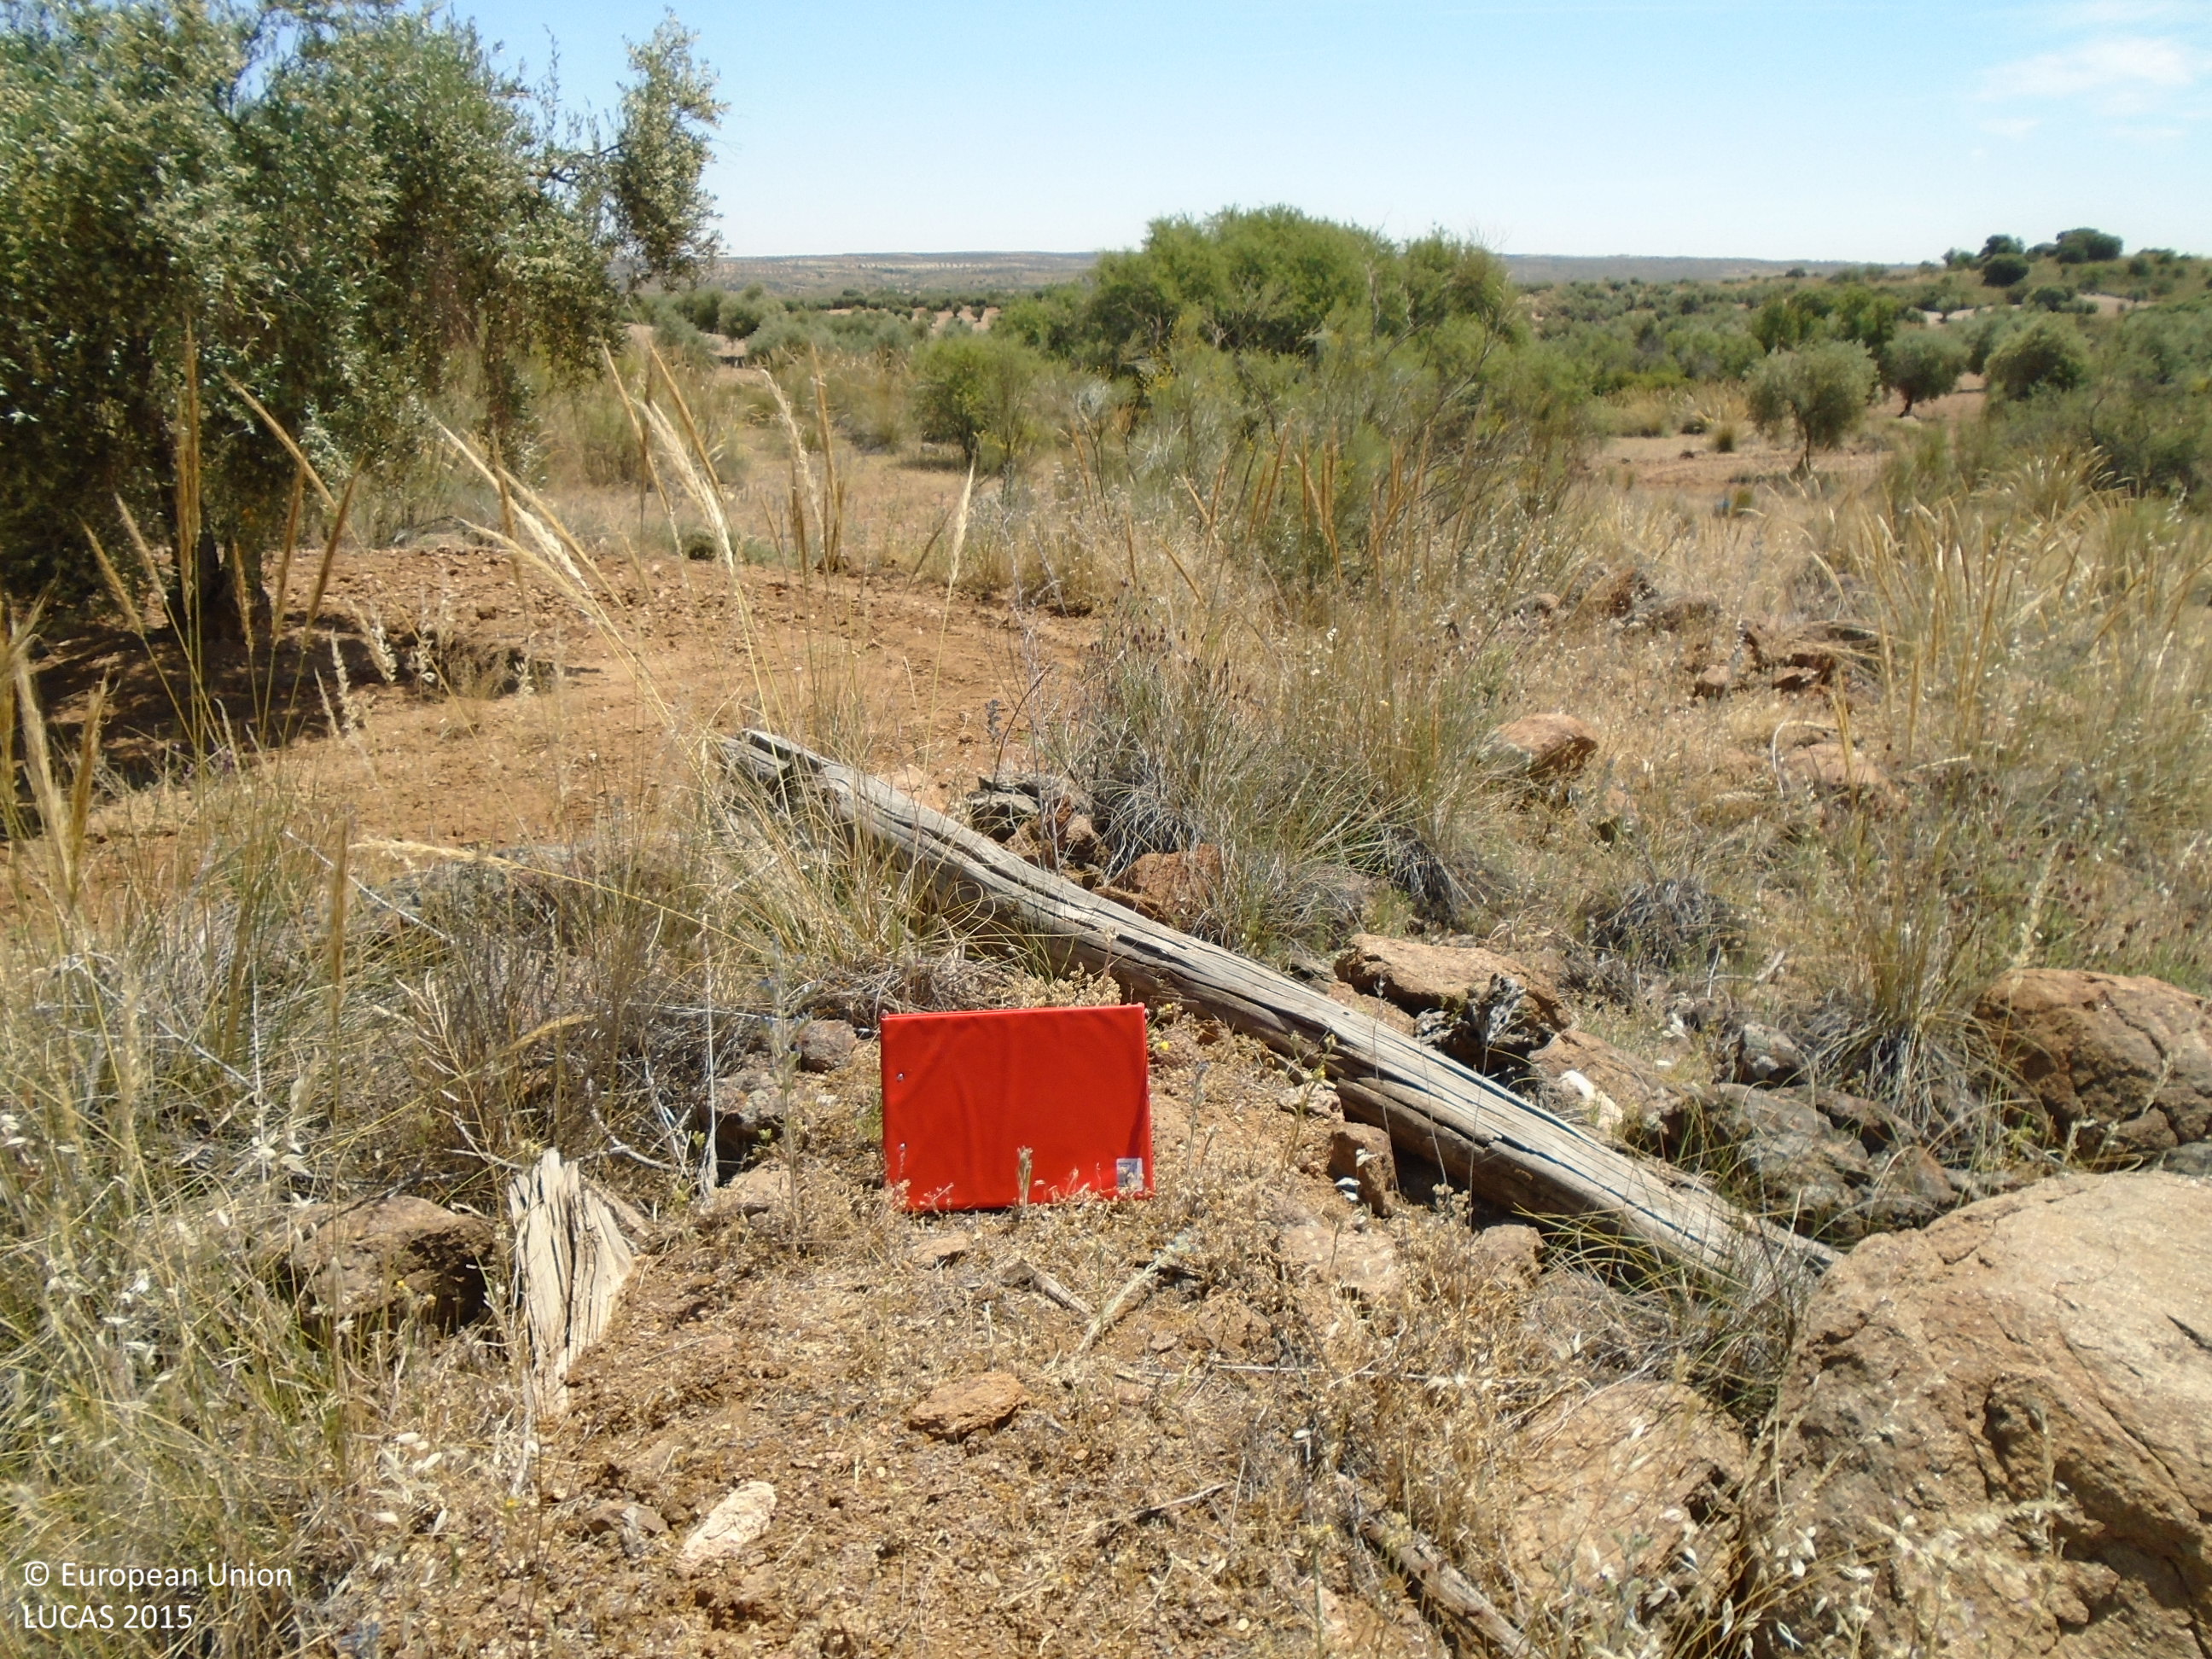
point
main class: Shrubland
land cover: Shrubland without tree cover
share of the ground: > 75 %
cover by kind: herbaceous plants 50 %, shrubs 40 %, consolidated bare surface 10 %
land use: Semi-natural and natural areas not in use
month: May
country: ES
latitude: 39.8033
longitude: -3.7775
